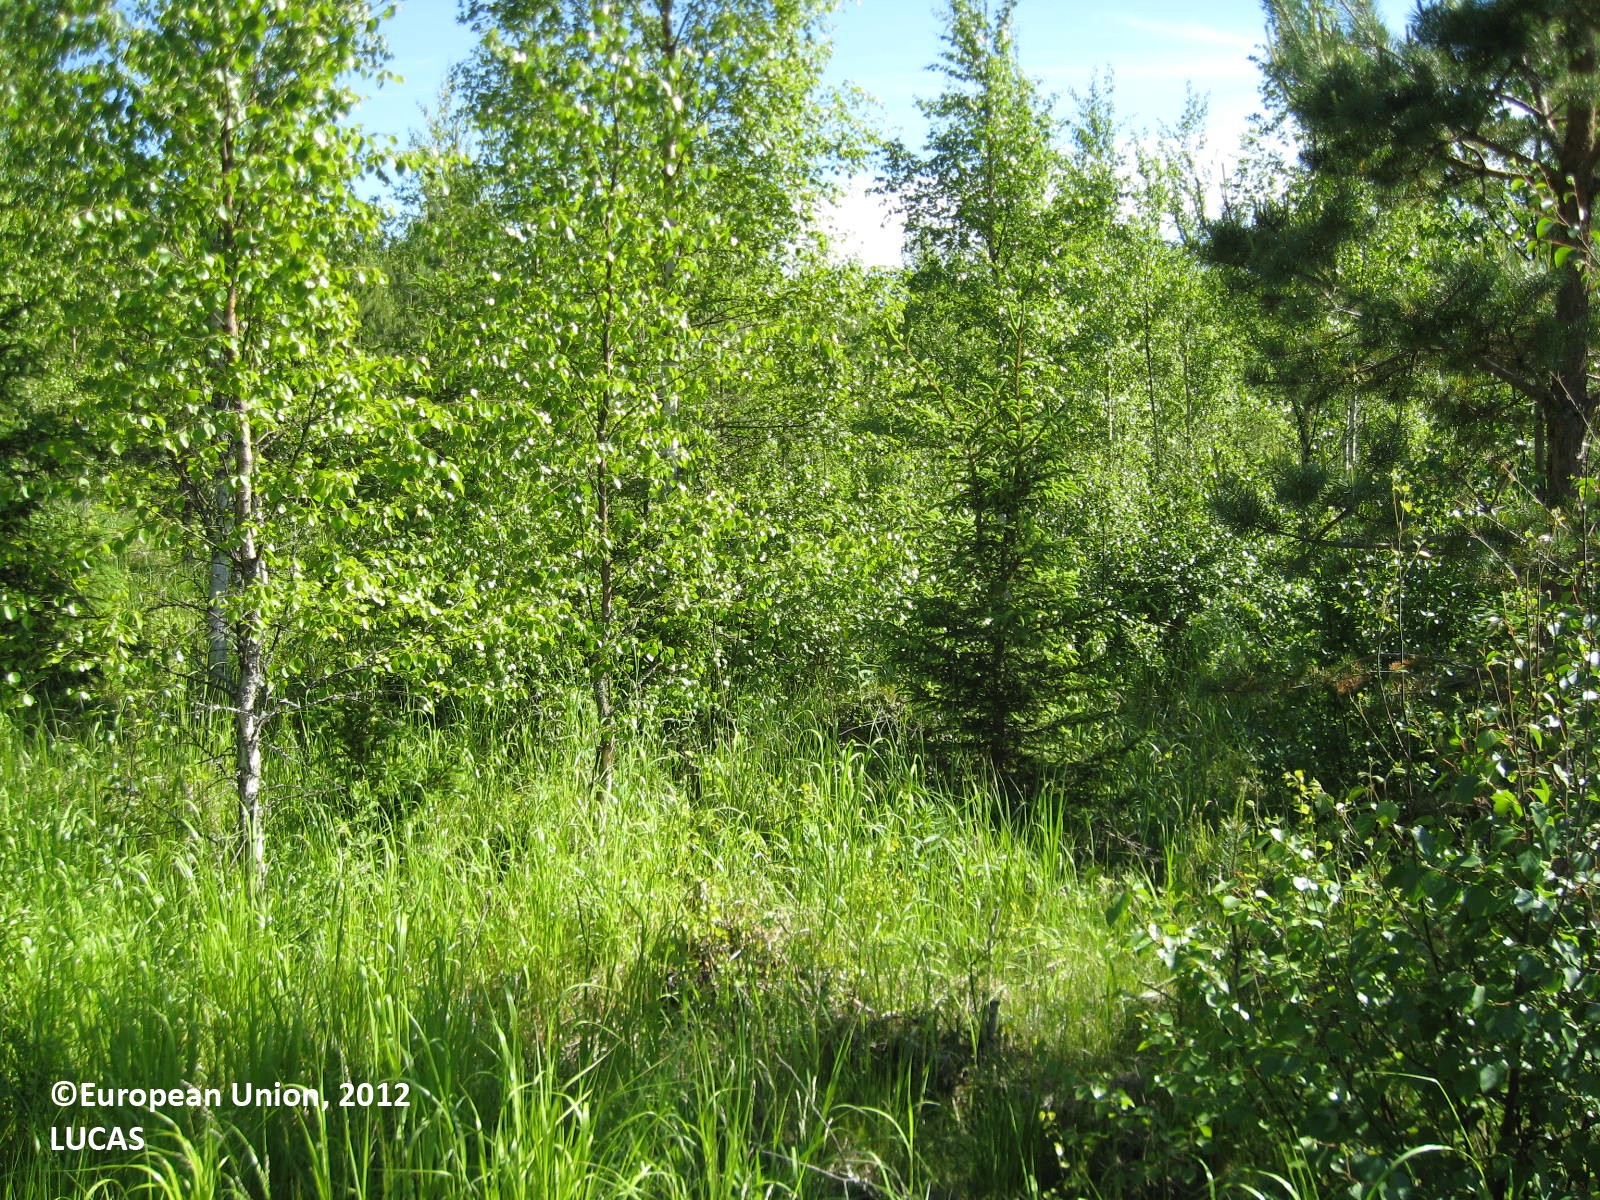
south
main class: Woodland
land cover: Other mixed woodland
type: boreal forest
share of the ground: 50 - 75 %
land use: Forestry
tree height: > 5 m
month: June
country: FI
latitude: 62.8080
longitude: 21.7540
